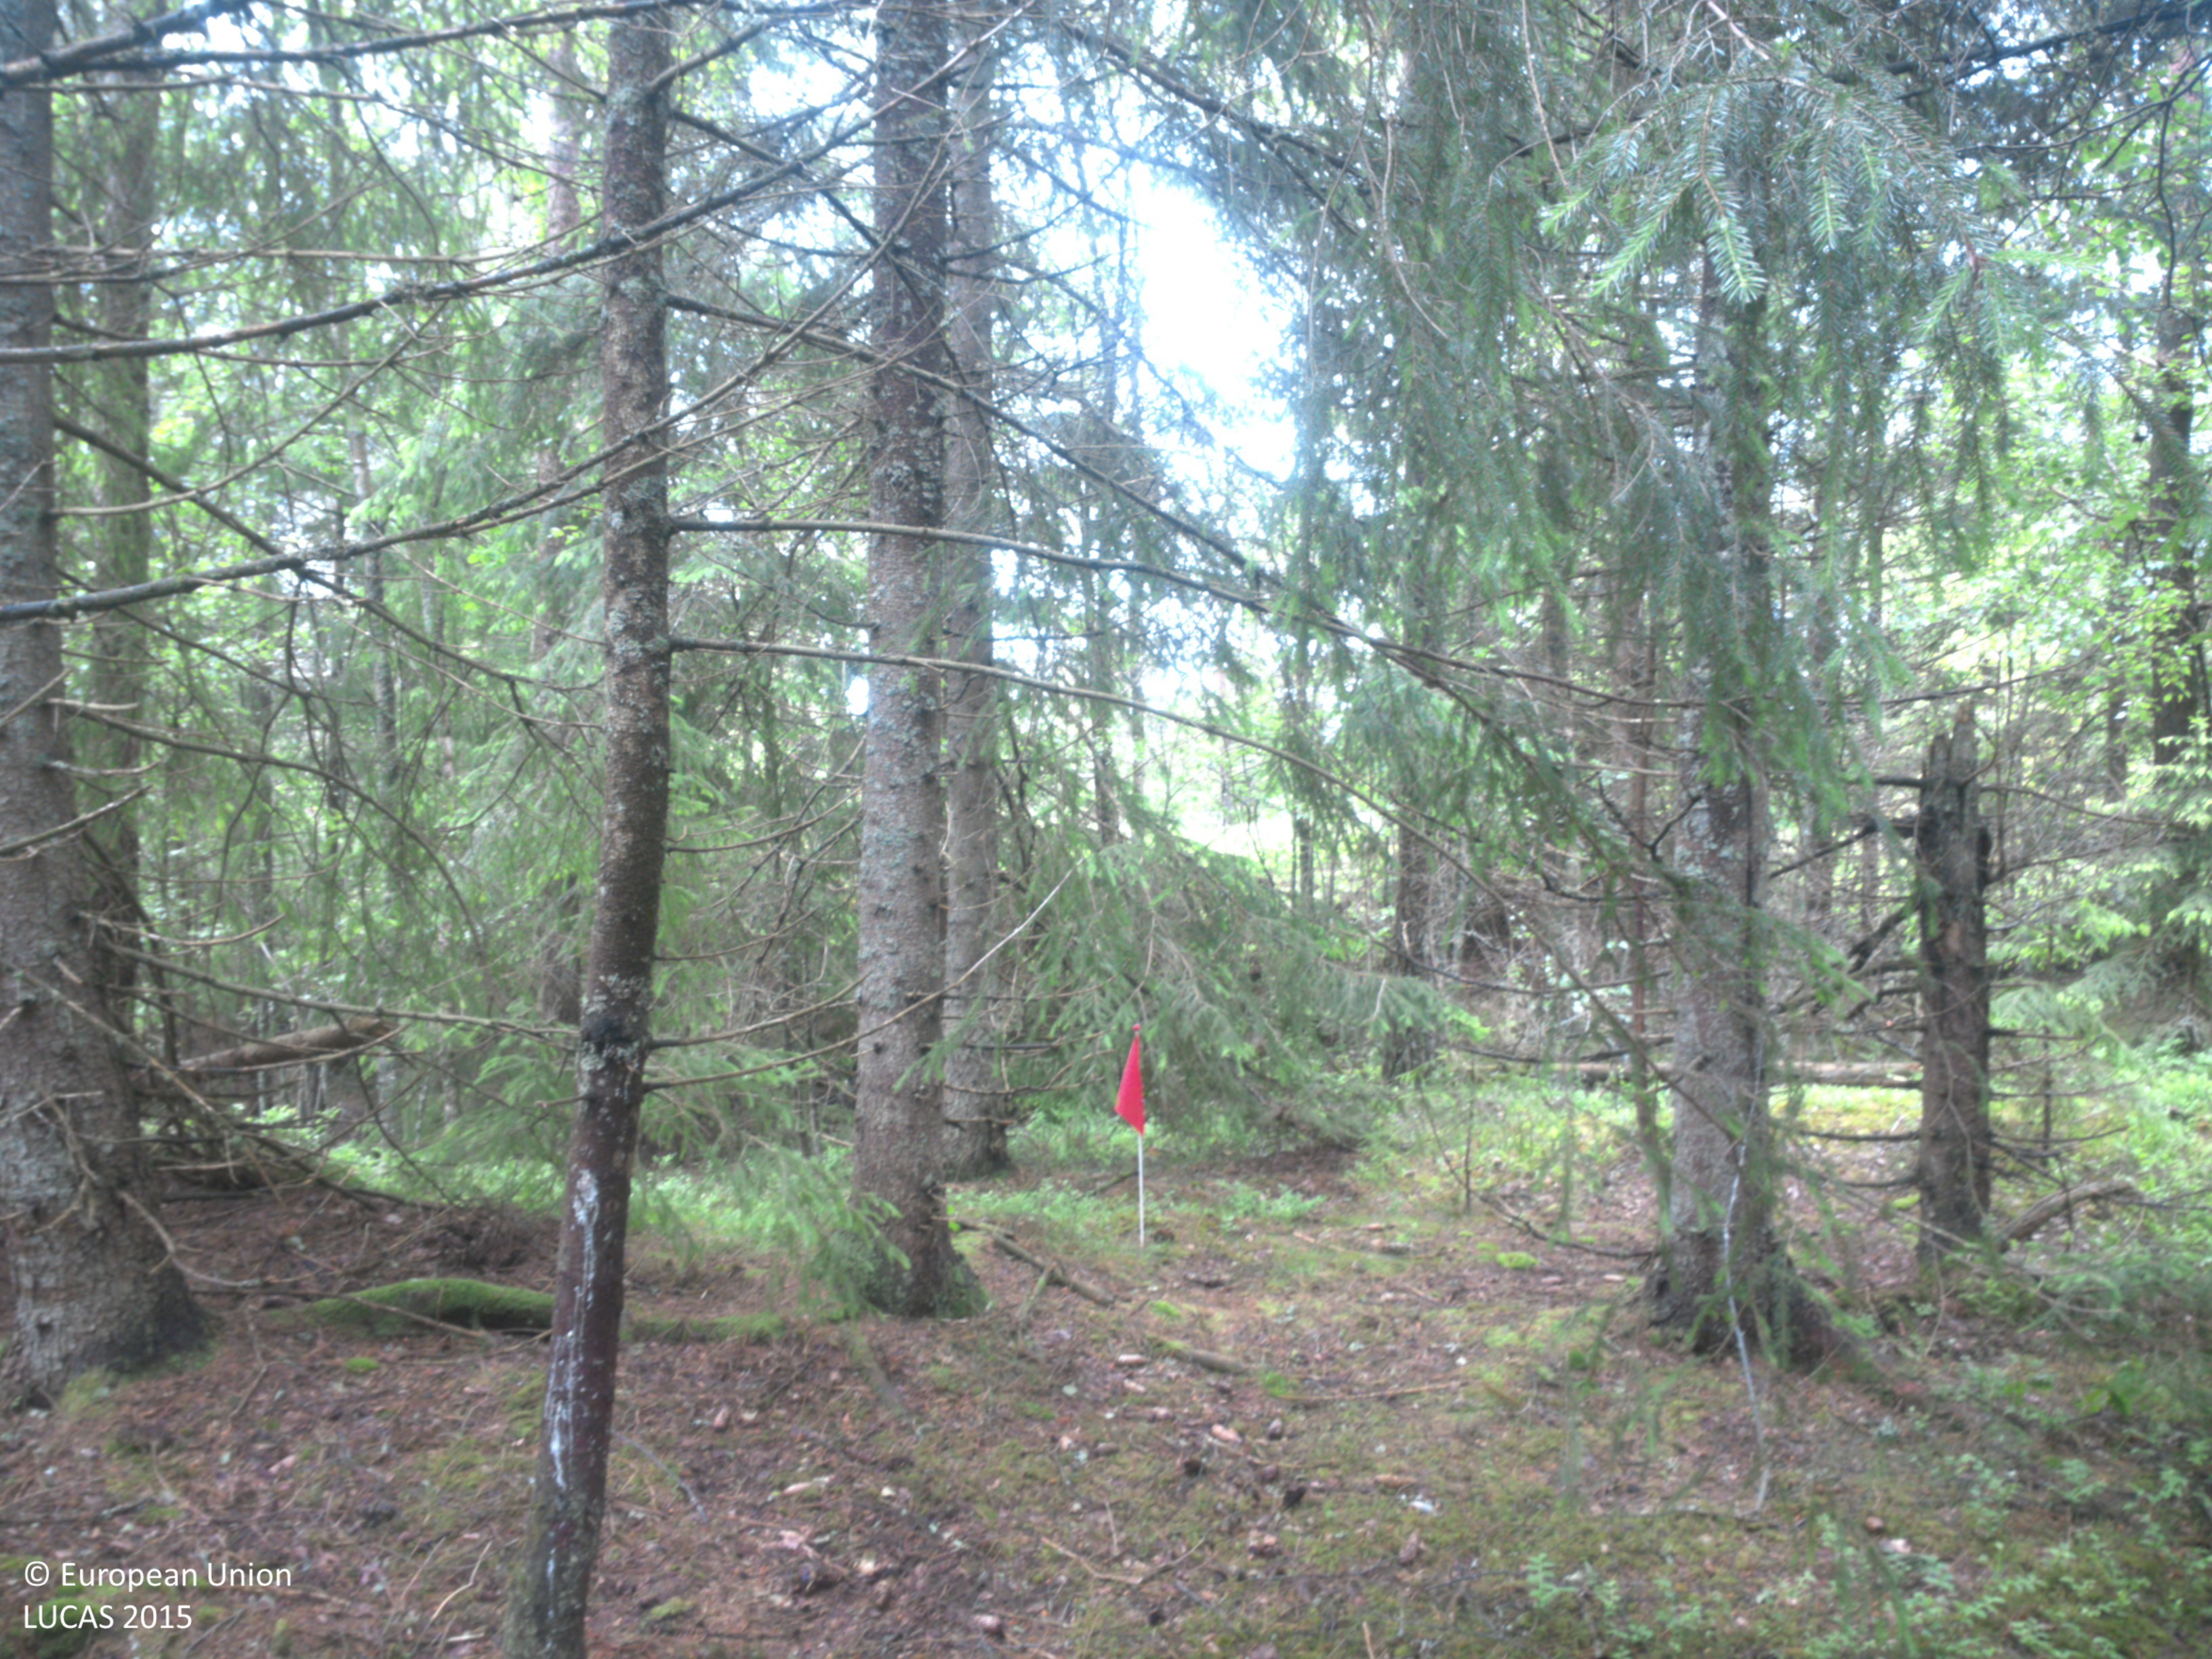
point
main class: Woodland
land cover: Spruce dominated coniferous woodland
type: boreal forest
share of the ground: 50 - 75 %
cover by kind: coniferous forest trees 50 %, lichens and mosses 40 %, broadleaved forest trees 5 %, shrubs 5 %
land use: Forestry
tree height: > 5 m
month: June
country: SE
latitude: 58.4773
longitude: 11.7968
